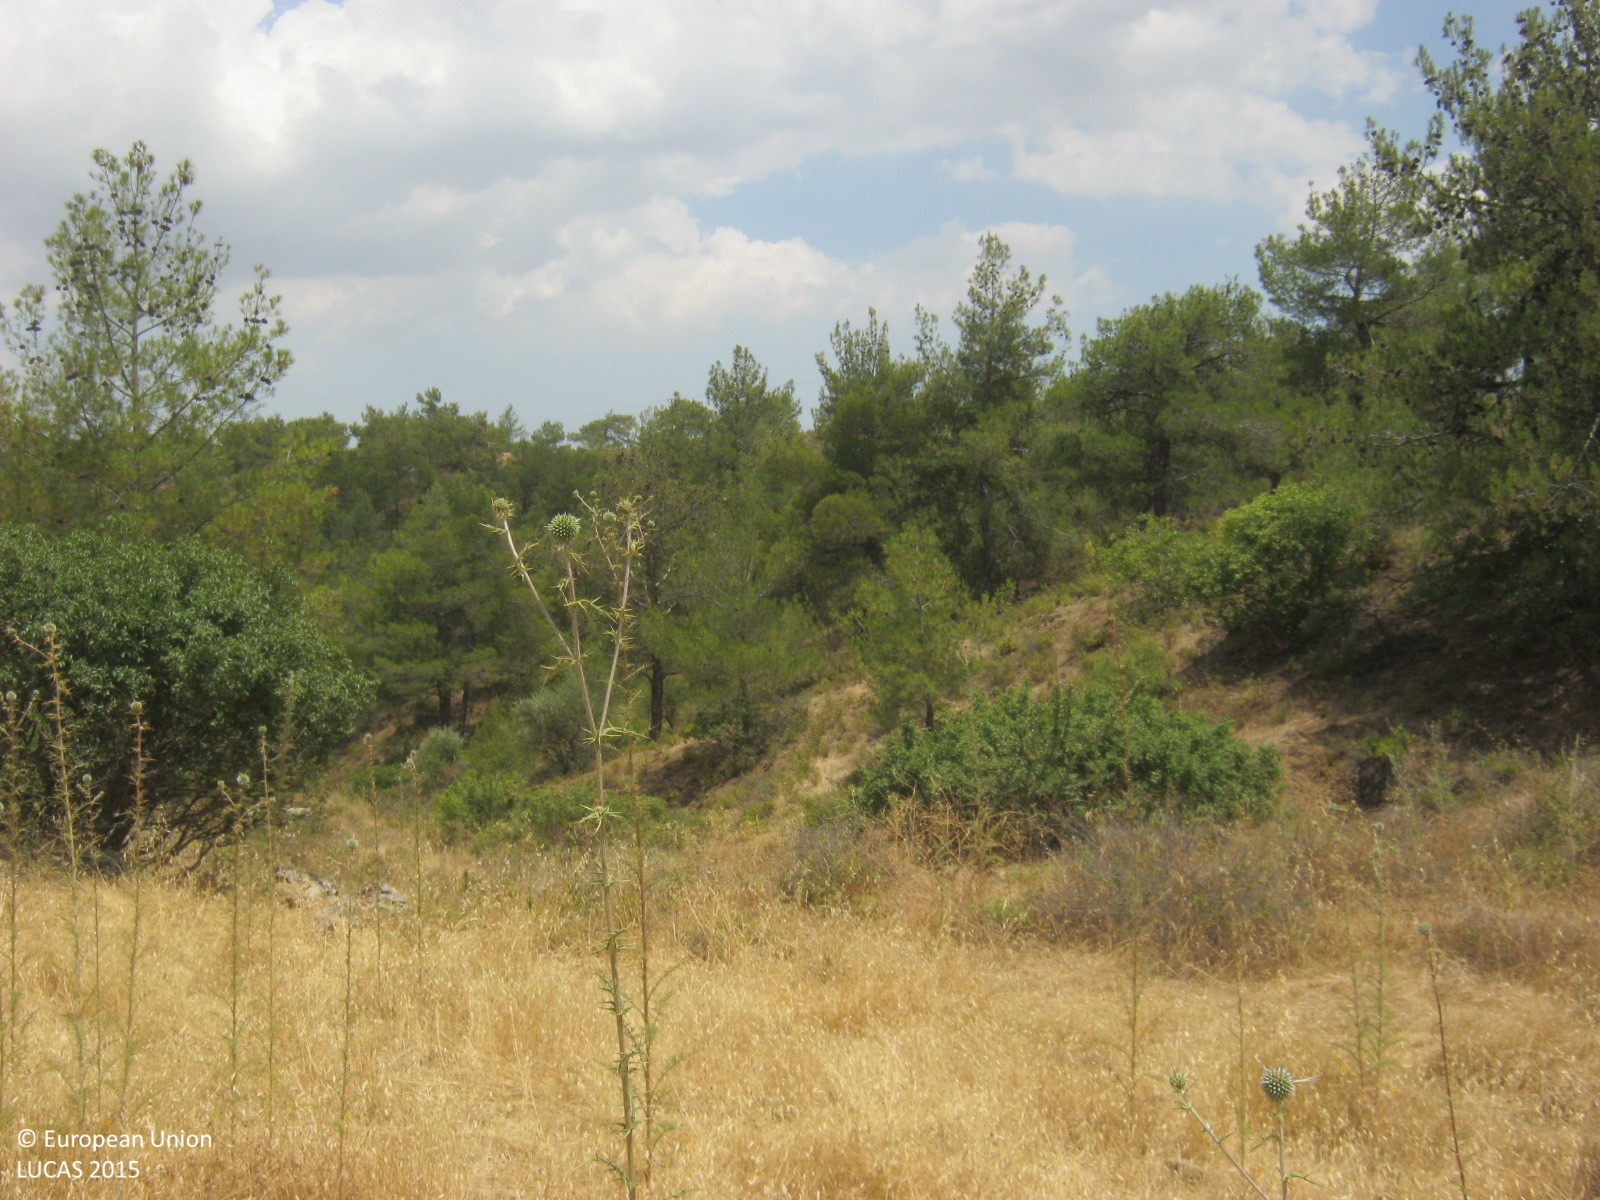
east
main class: Grassland
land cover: Grassland with sparse tree/shrub cover
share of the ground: > 75 %
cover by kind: herbaceous plants 90 %, coniferous forest trees 5 %, shrubs 5 %
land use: Semi-natural and natural areas not in use
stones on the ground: 10 - 25 %
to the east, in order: Grassland with sparse tree/shrub cover; Shrubland with sparse tree cover; Pine dominated coniferous woodland; Rivers and streams; Shrubland with sparse tree cover; Pine dominated coniferous woodland; Rivers and streams; Pine dominated coniferous woodland; Paved roads, cycling and walking lanes; Electric lines
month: June
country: CY
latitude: 34.9871
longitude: 33.1978
